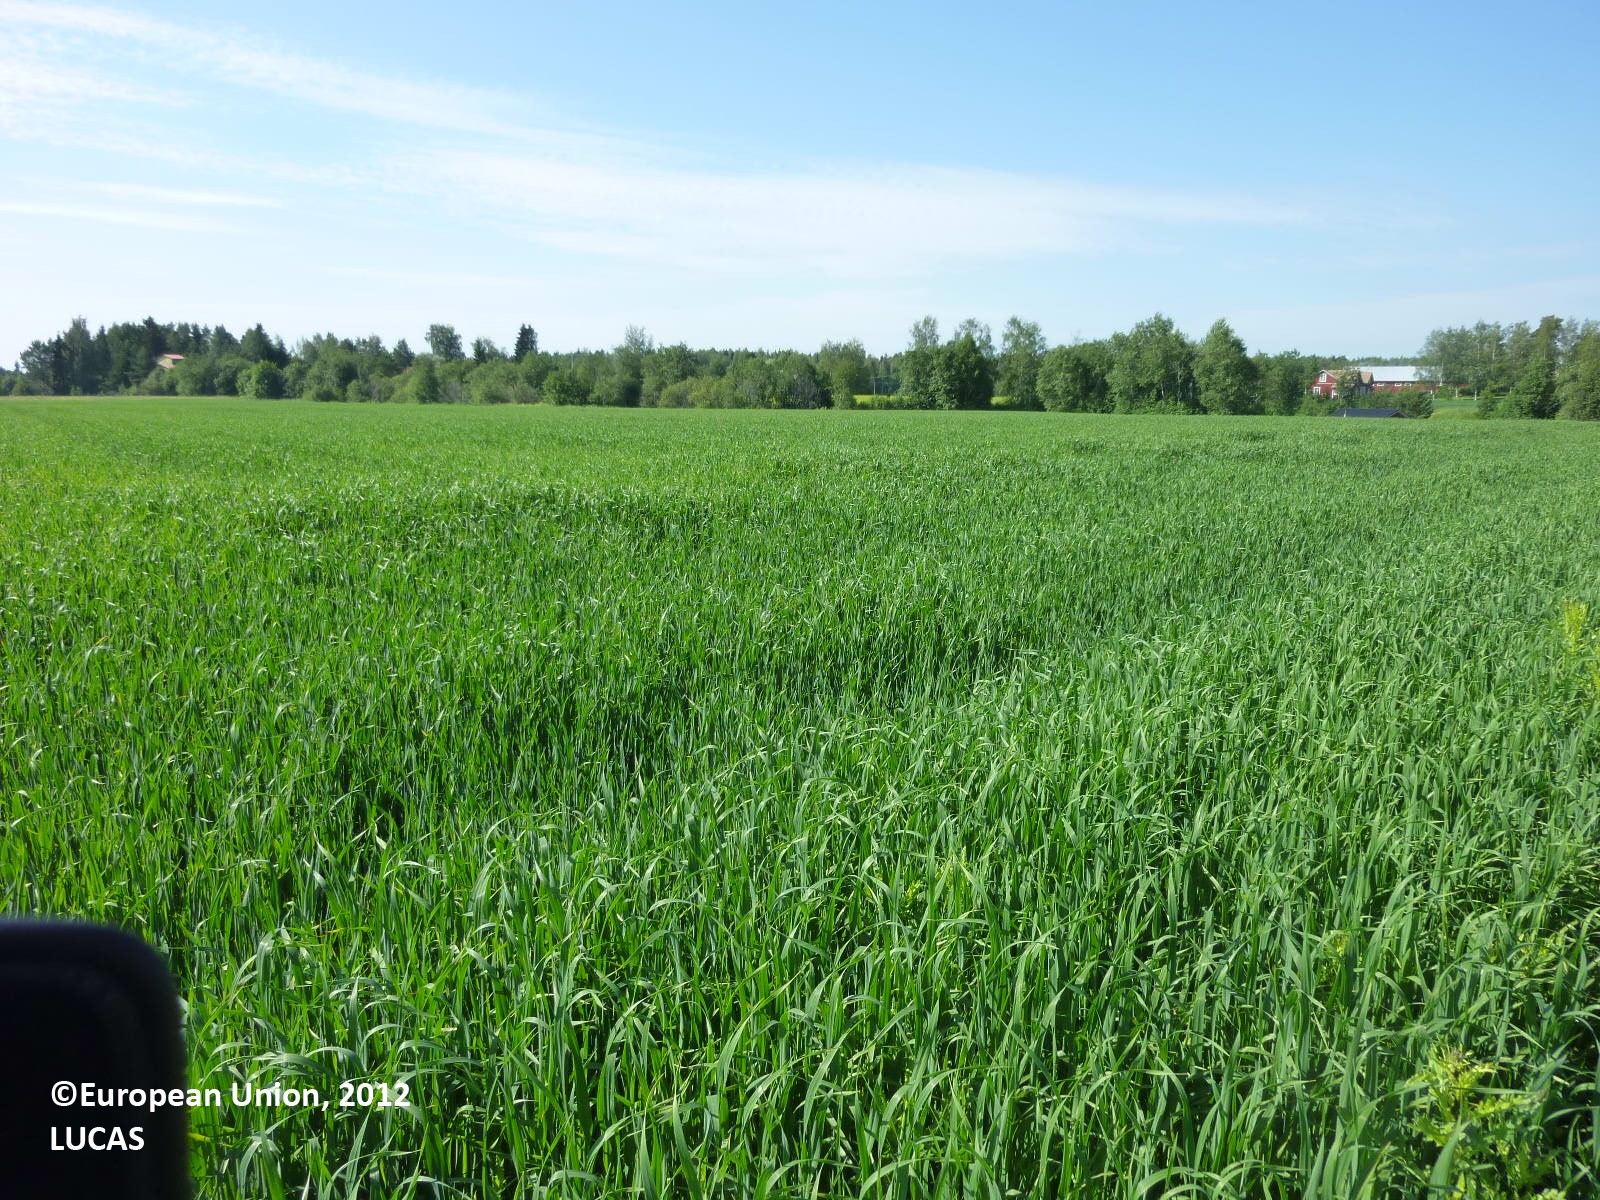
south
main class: Cropland
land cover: Rye
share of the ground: > 75 %
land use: Agriculture (excluding fallow land and kitchen gardens)
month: July
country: FI
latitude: 61.2400
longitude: 22.3790
